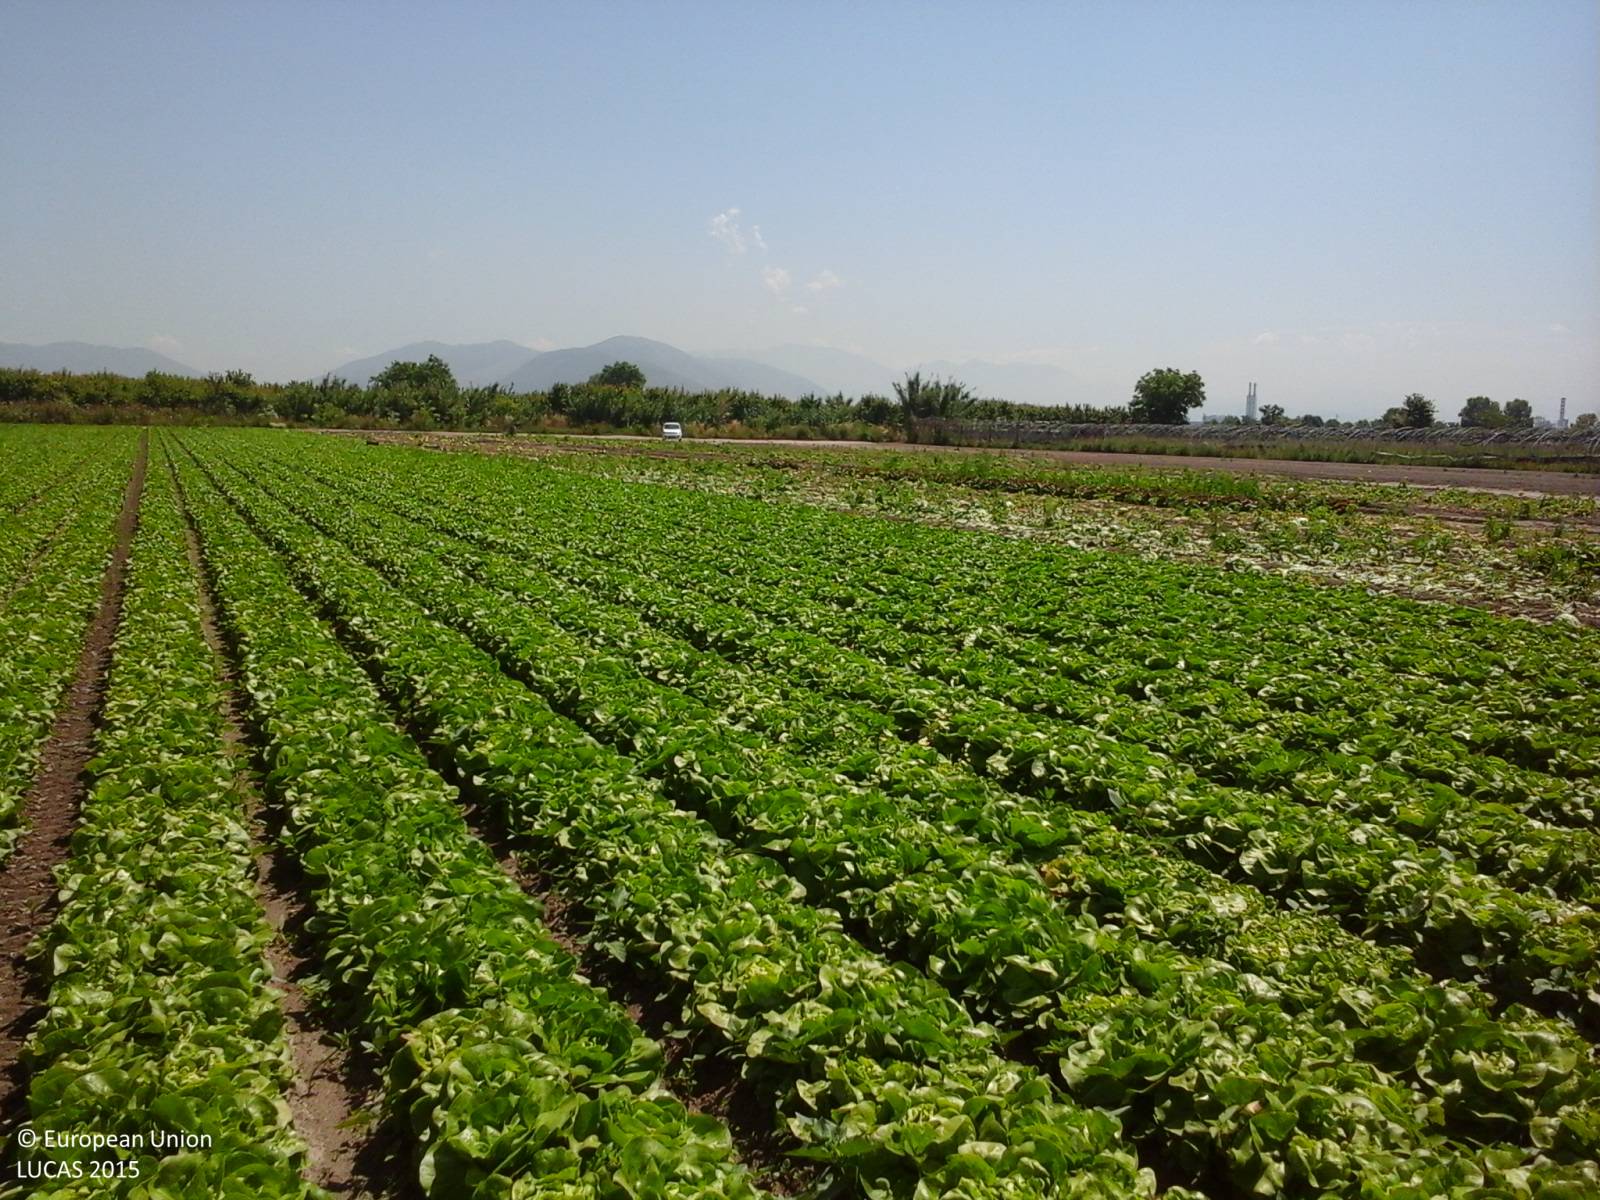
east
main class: Cropland
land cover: Other fresh vegetables
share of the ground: > 75 %
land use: Agriculture (excluding fallow land and kitchen gardens)
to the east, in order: Other fresh vegetables; Tracks; Grass margins; Inland fresh running water; Abandoned hedges; Other fruit trees and berries; Grass margins; Tracks; Grass margins; Fences; Other fruit trees and berries
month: June
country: IT
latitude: 40.9864
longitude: 14.3446
